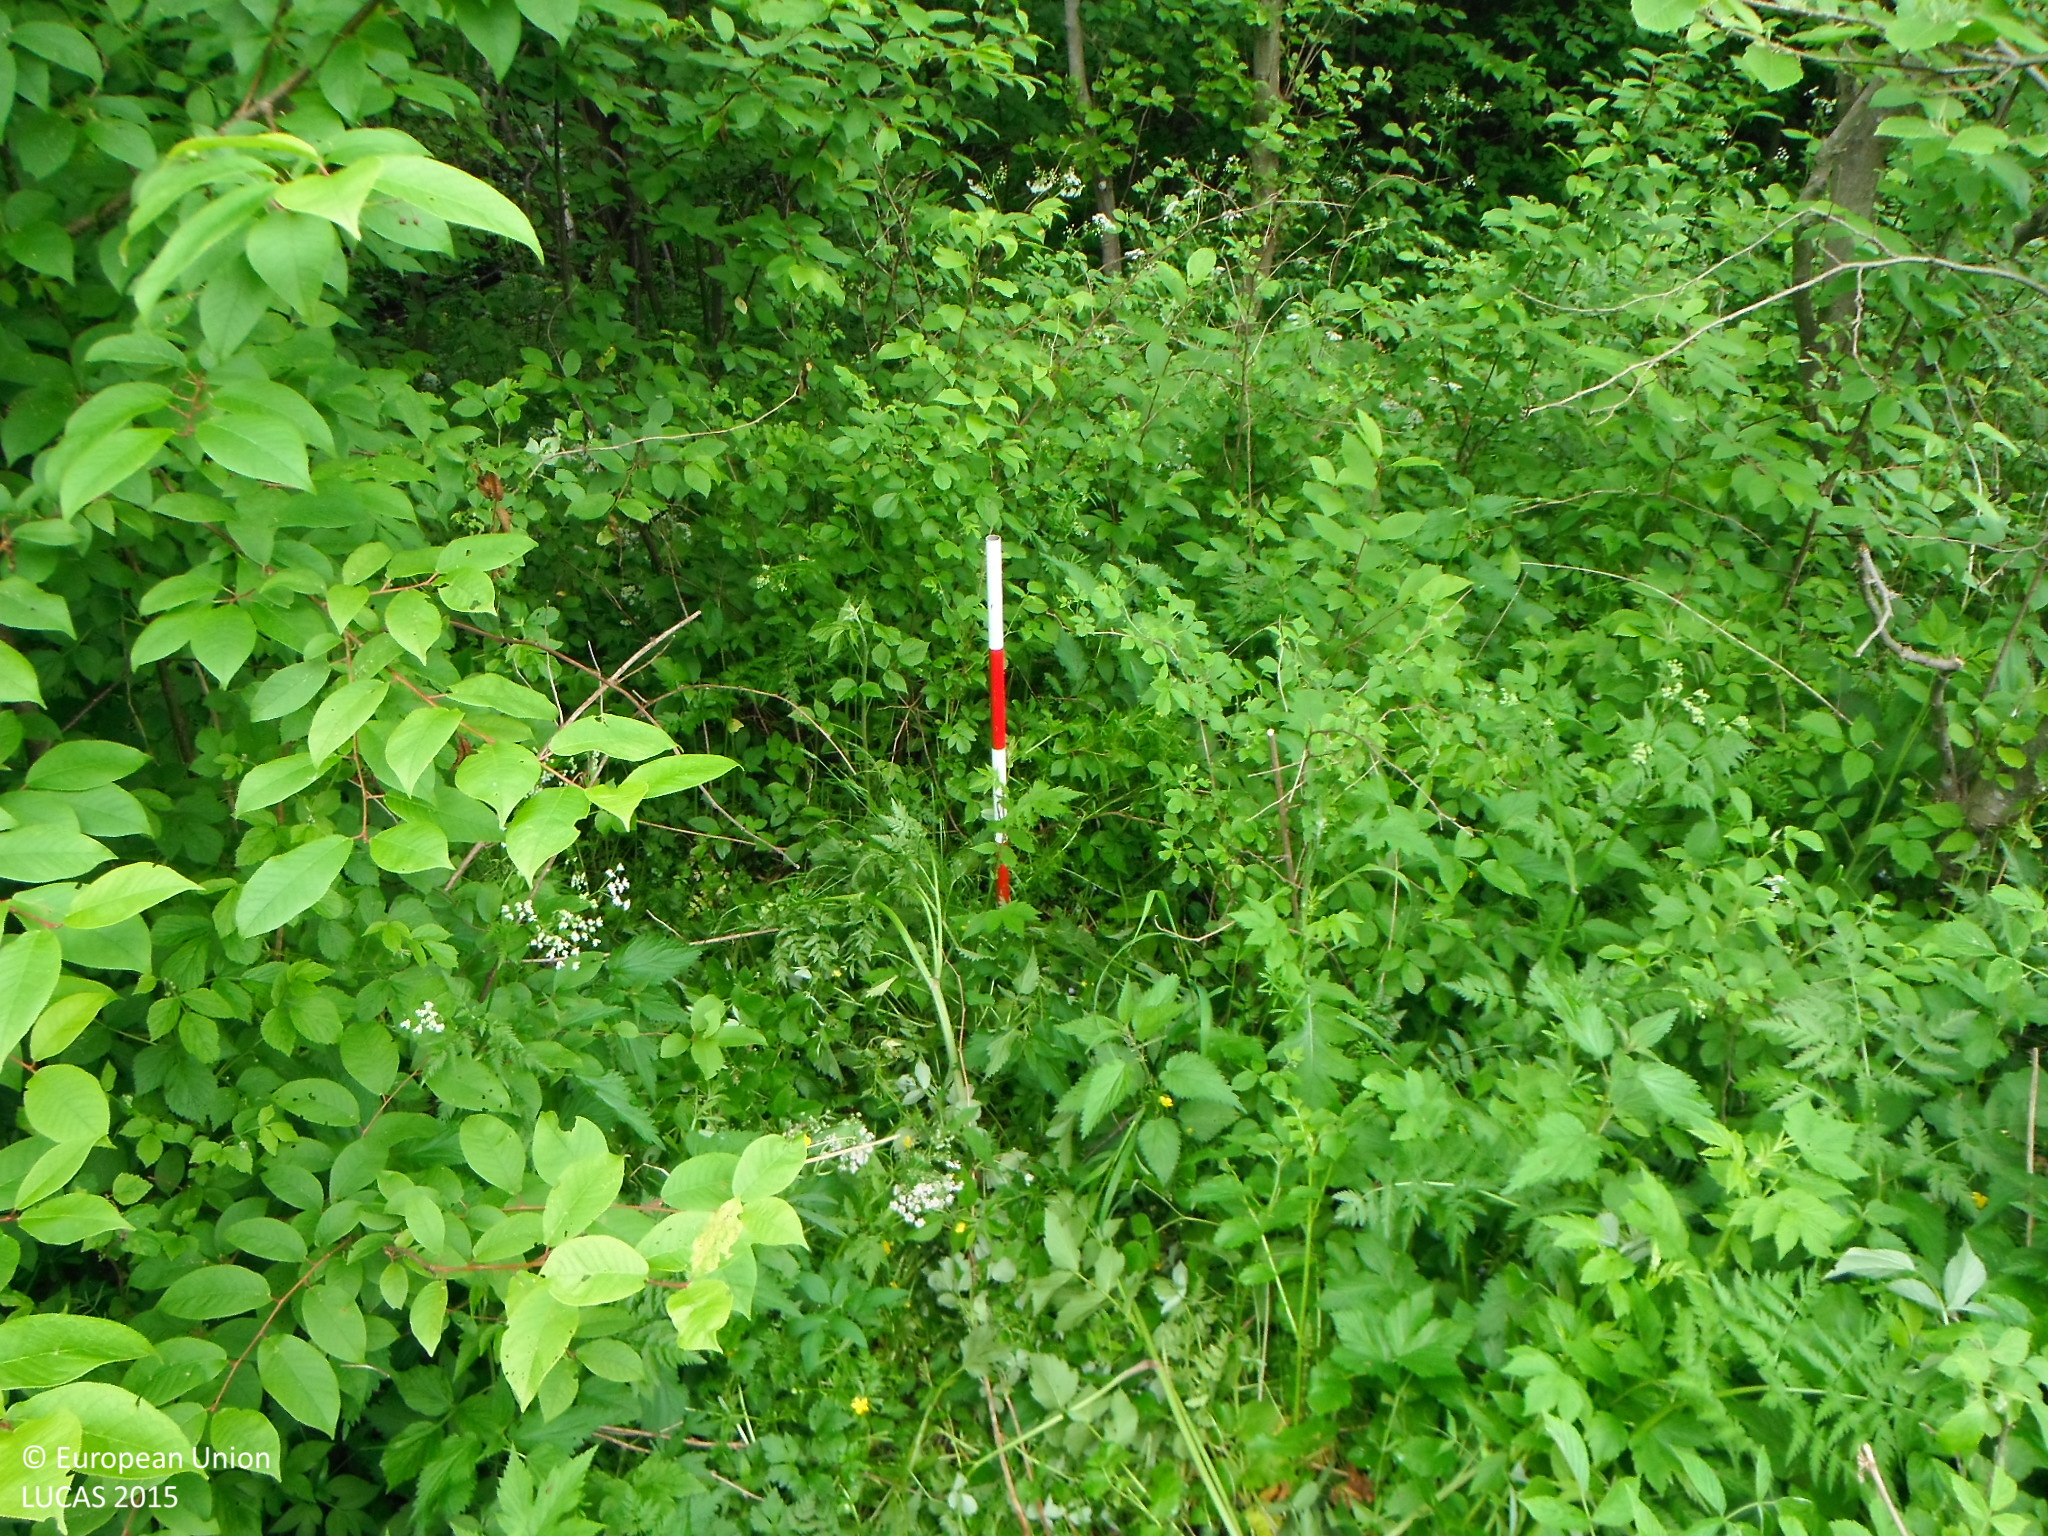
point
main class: Shrubland
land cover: Shrubland with sparse tree cover
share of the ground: > 75 %
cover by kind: shrubs 85 %, herbaceous plants 10 %, broadleaved forest trees 5 %
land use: Semi-natural and natural areas not in use
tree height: > 5 m
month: June
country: SK
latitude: 48.8064
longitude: 19.7360
